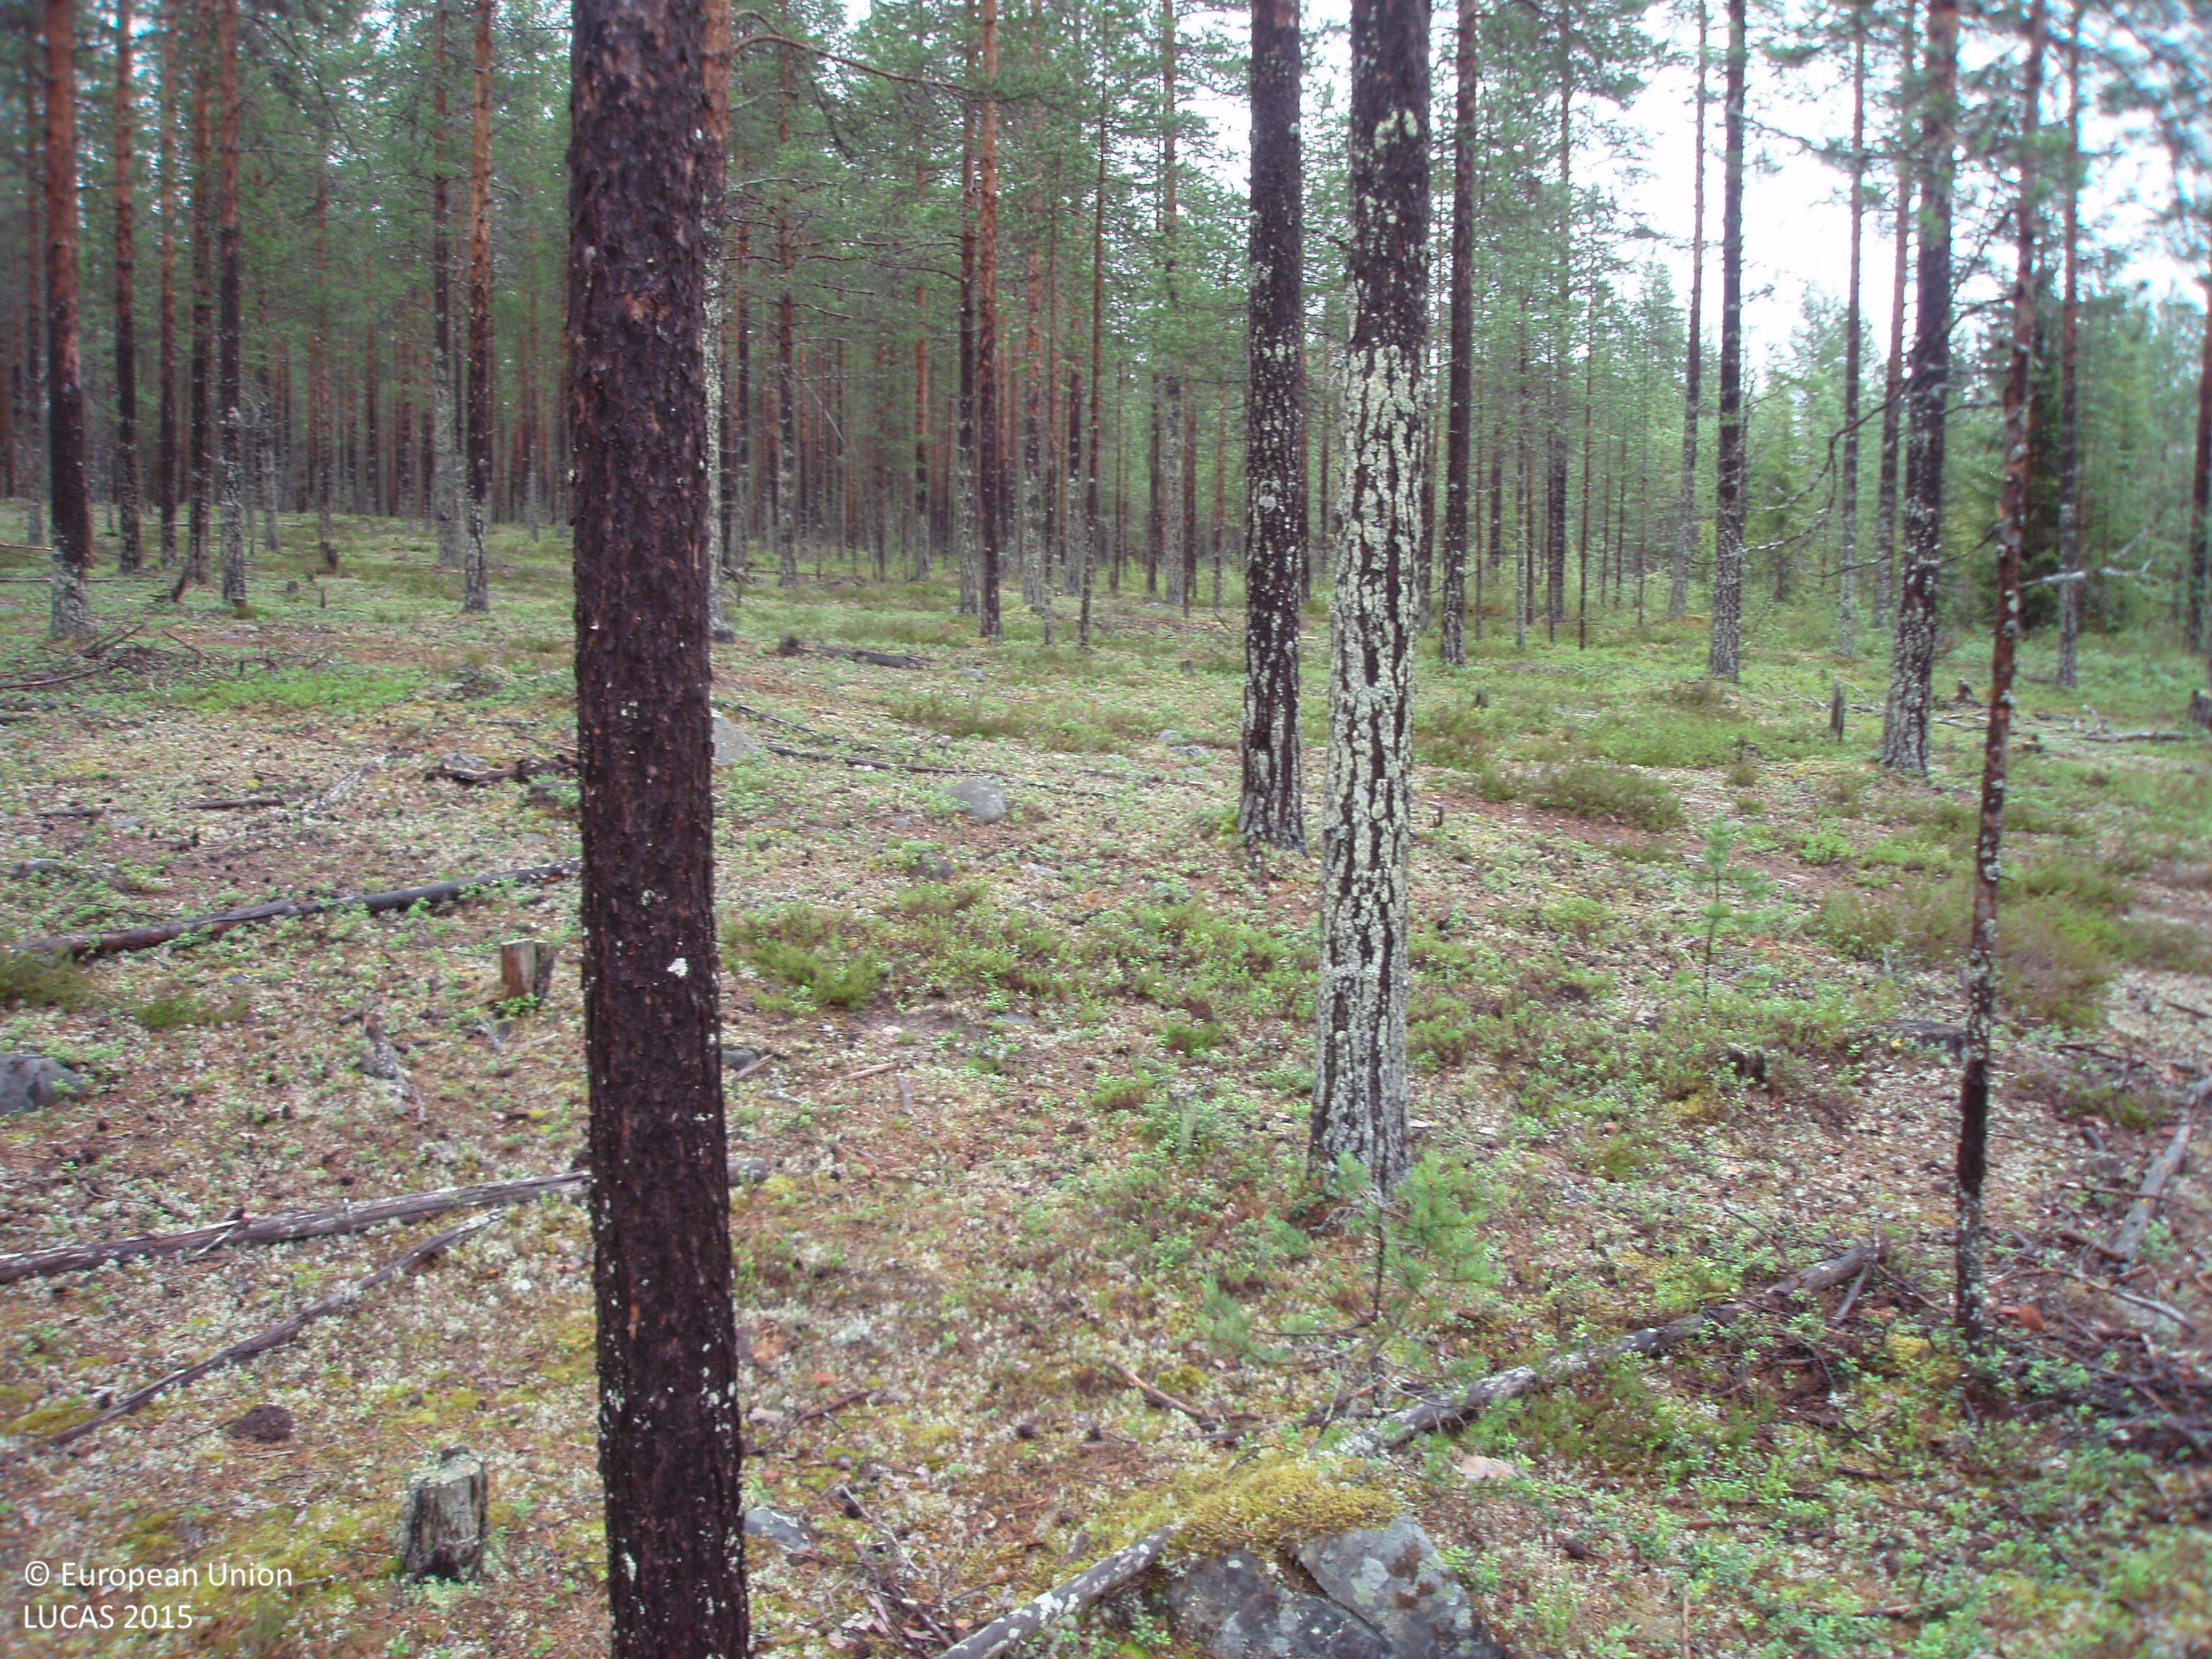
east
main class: Woodland
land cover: Pine dominated coniferous woodland
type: boreal forest
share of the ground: 50 - 75 %
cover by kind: coniferous forest trees 60 %, shrubs 30 %, lichens and mosses 10 %
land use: Forestry
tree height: > 5 m
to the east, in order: Pine dominated coniferous woodland; Other coniferous woodland; Pine dominated coniferous woodland; Other coniferous woodland
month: July
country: FI
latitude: 65.9958
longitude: 27.9125
